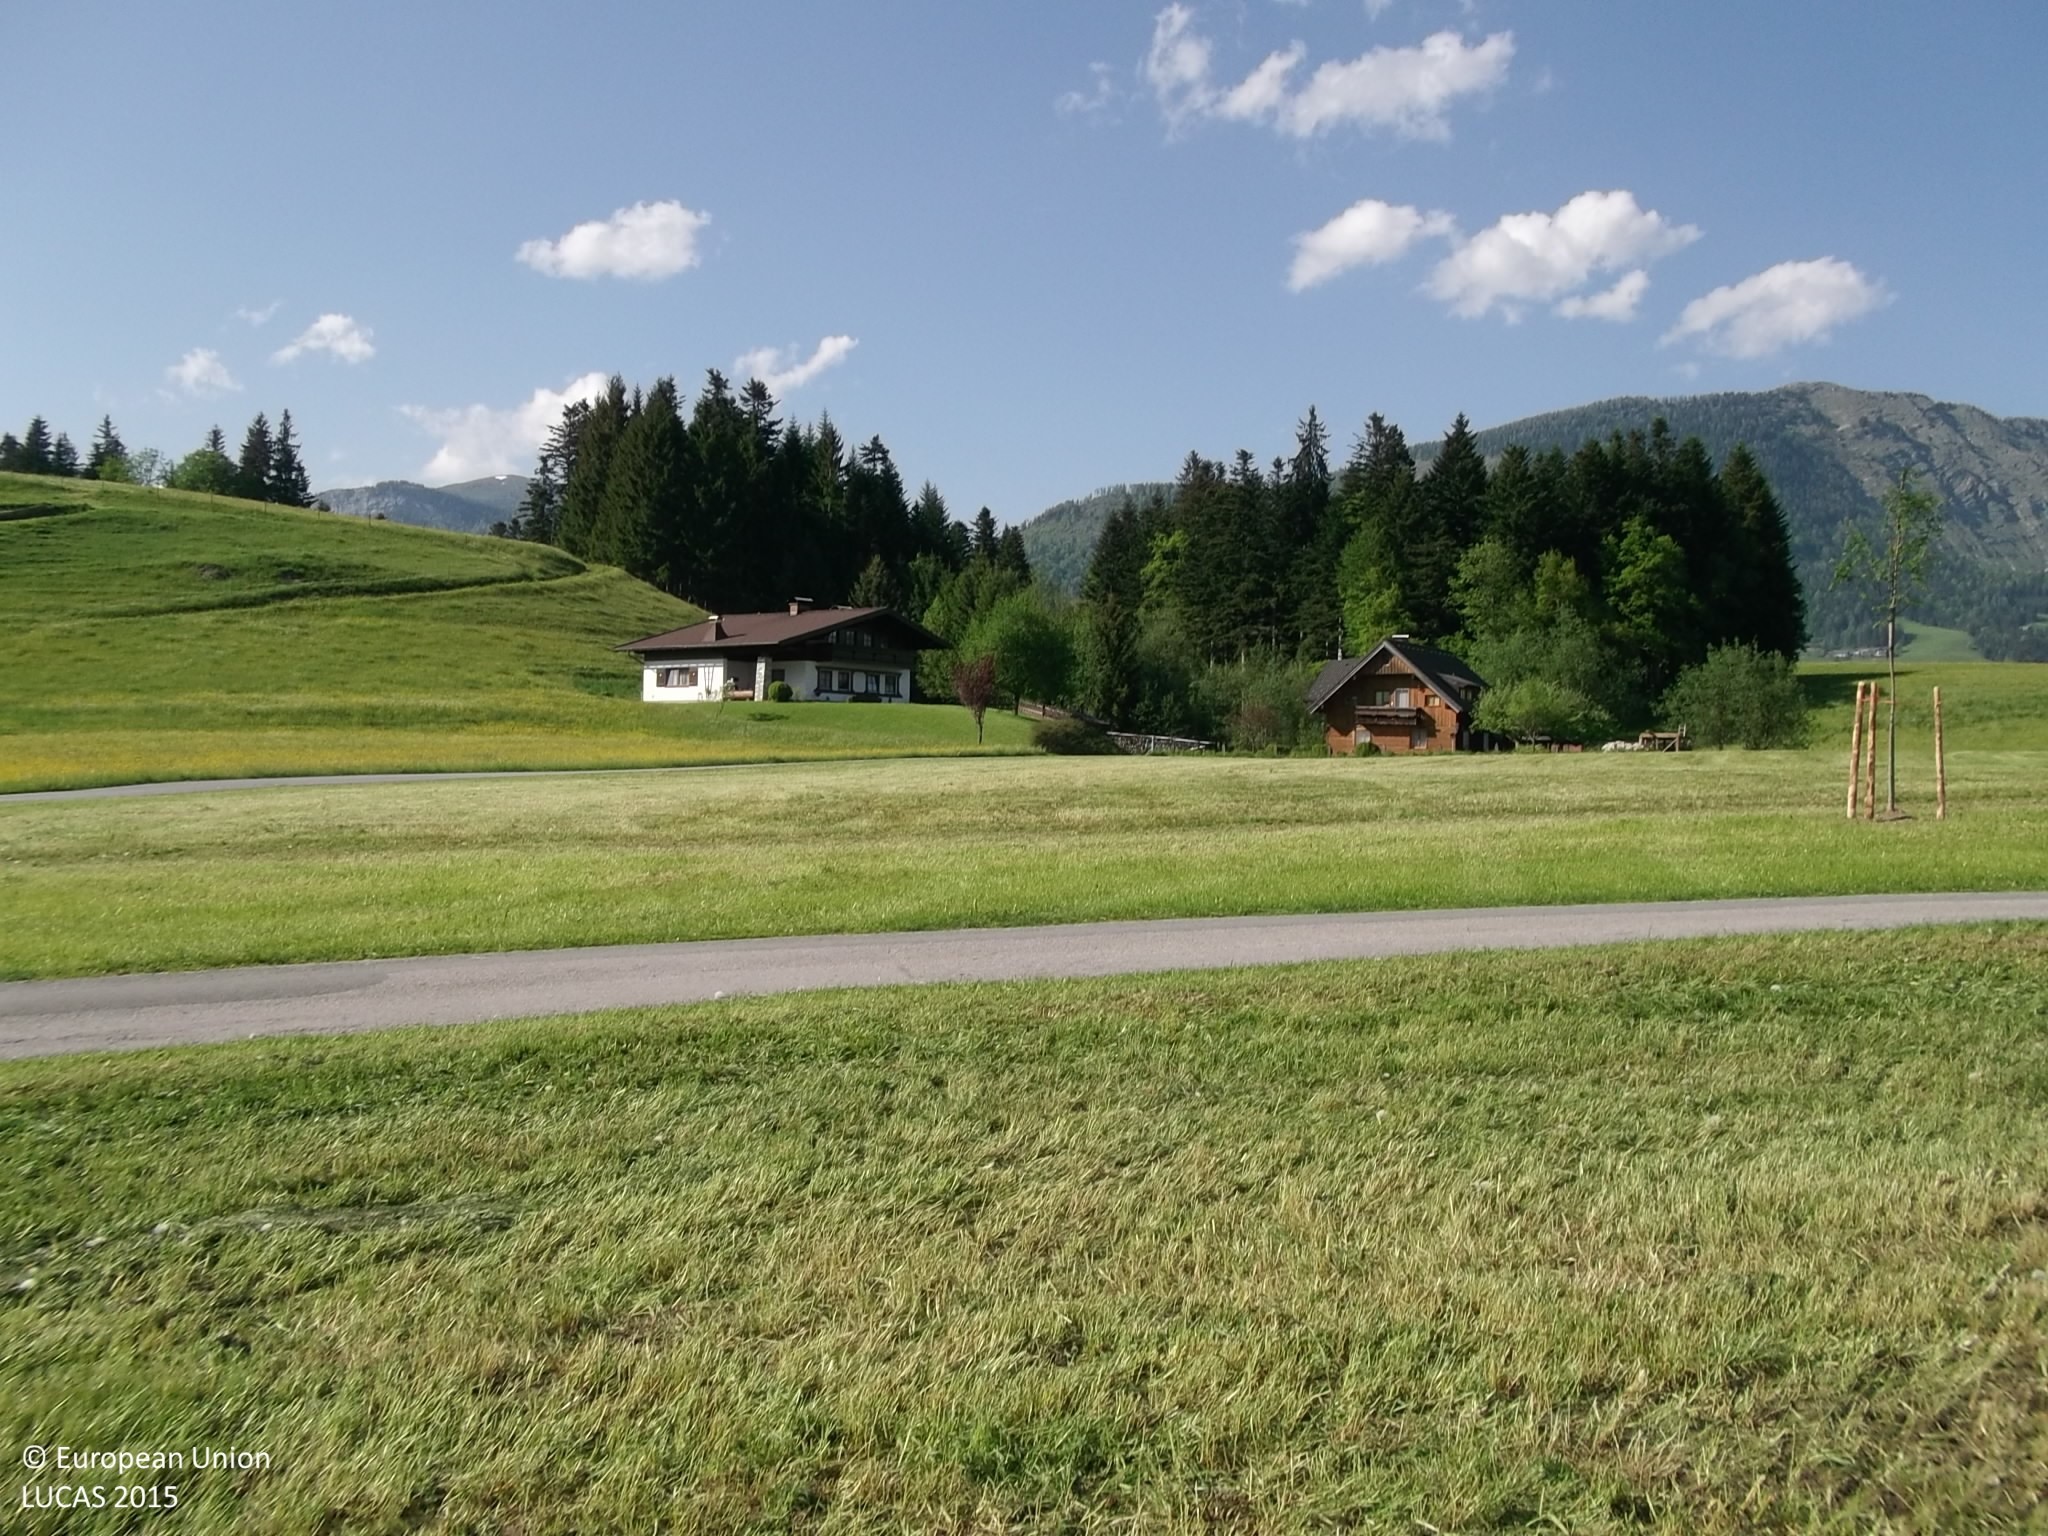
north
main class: Grassland
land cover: Grassland without tree/shrub cover
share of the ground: > 75 %
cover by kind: herbaceous plants 100 %
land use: Agriculture (excluding fallow land and kitchen gardens)
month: May
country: AT
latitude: 47.5787
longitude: 13.3355
